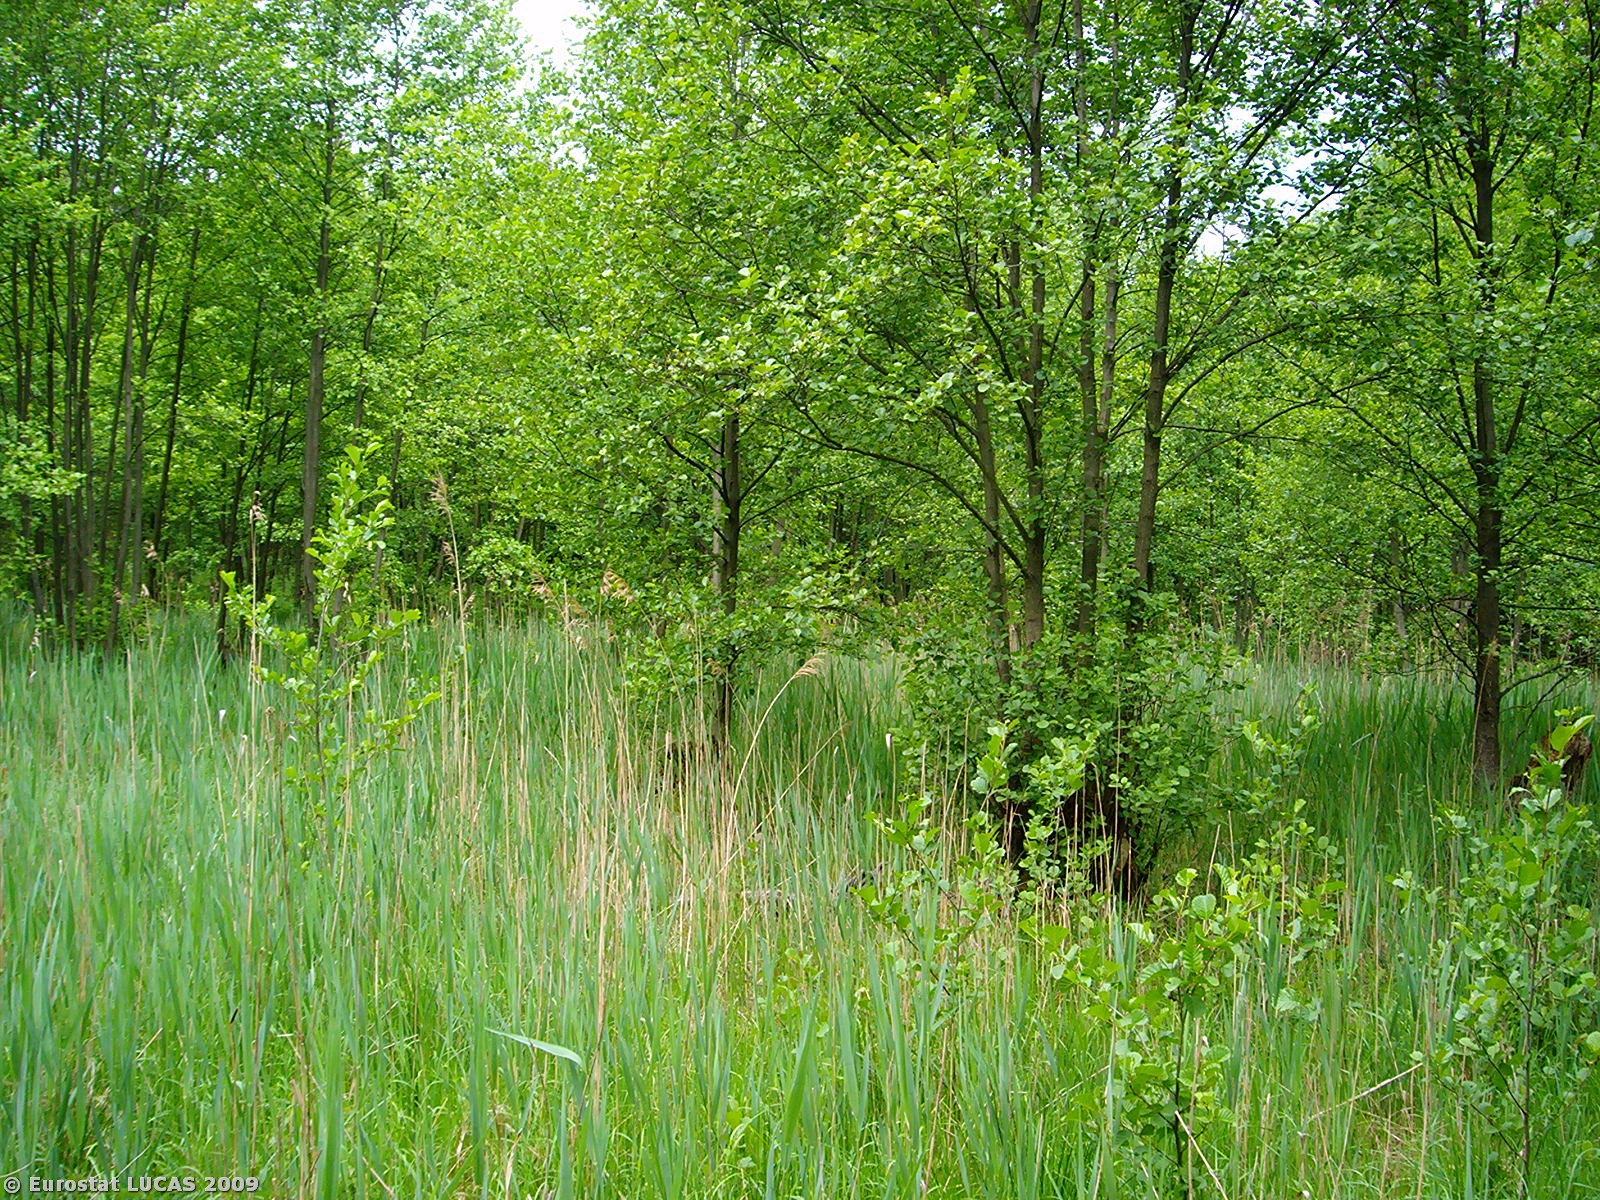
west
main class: Woodland
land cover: Broadleaved woodland
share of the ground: 50 - 75 %
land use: Forestry
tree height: < 5 m
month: May
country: PL
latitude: 52.6210
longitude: 16.3734
